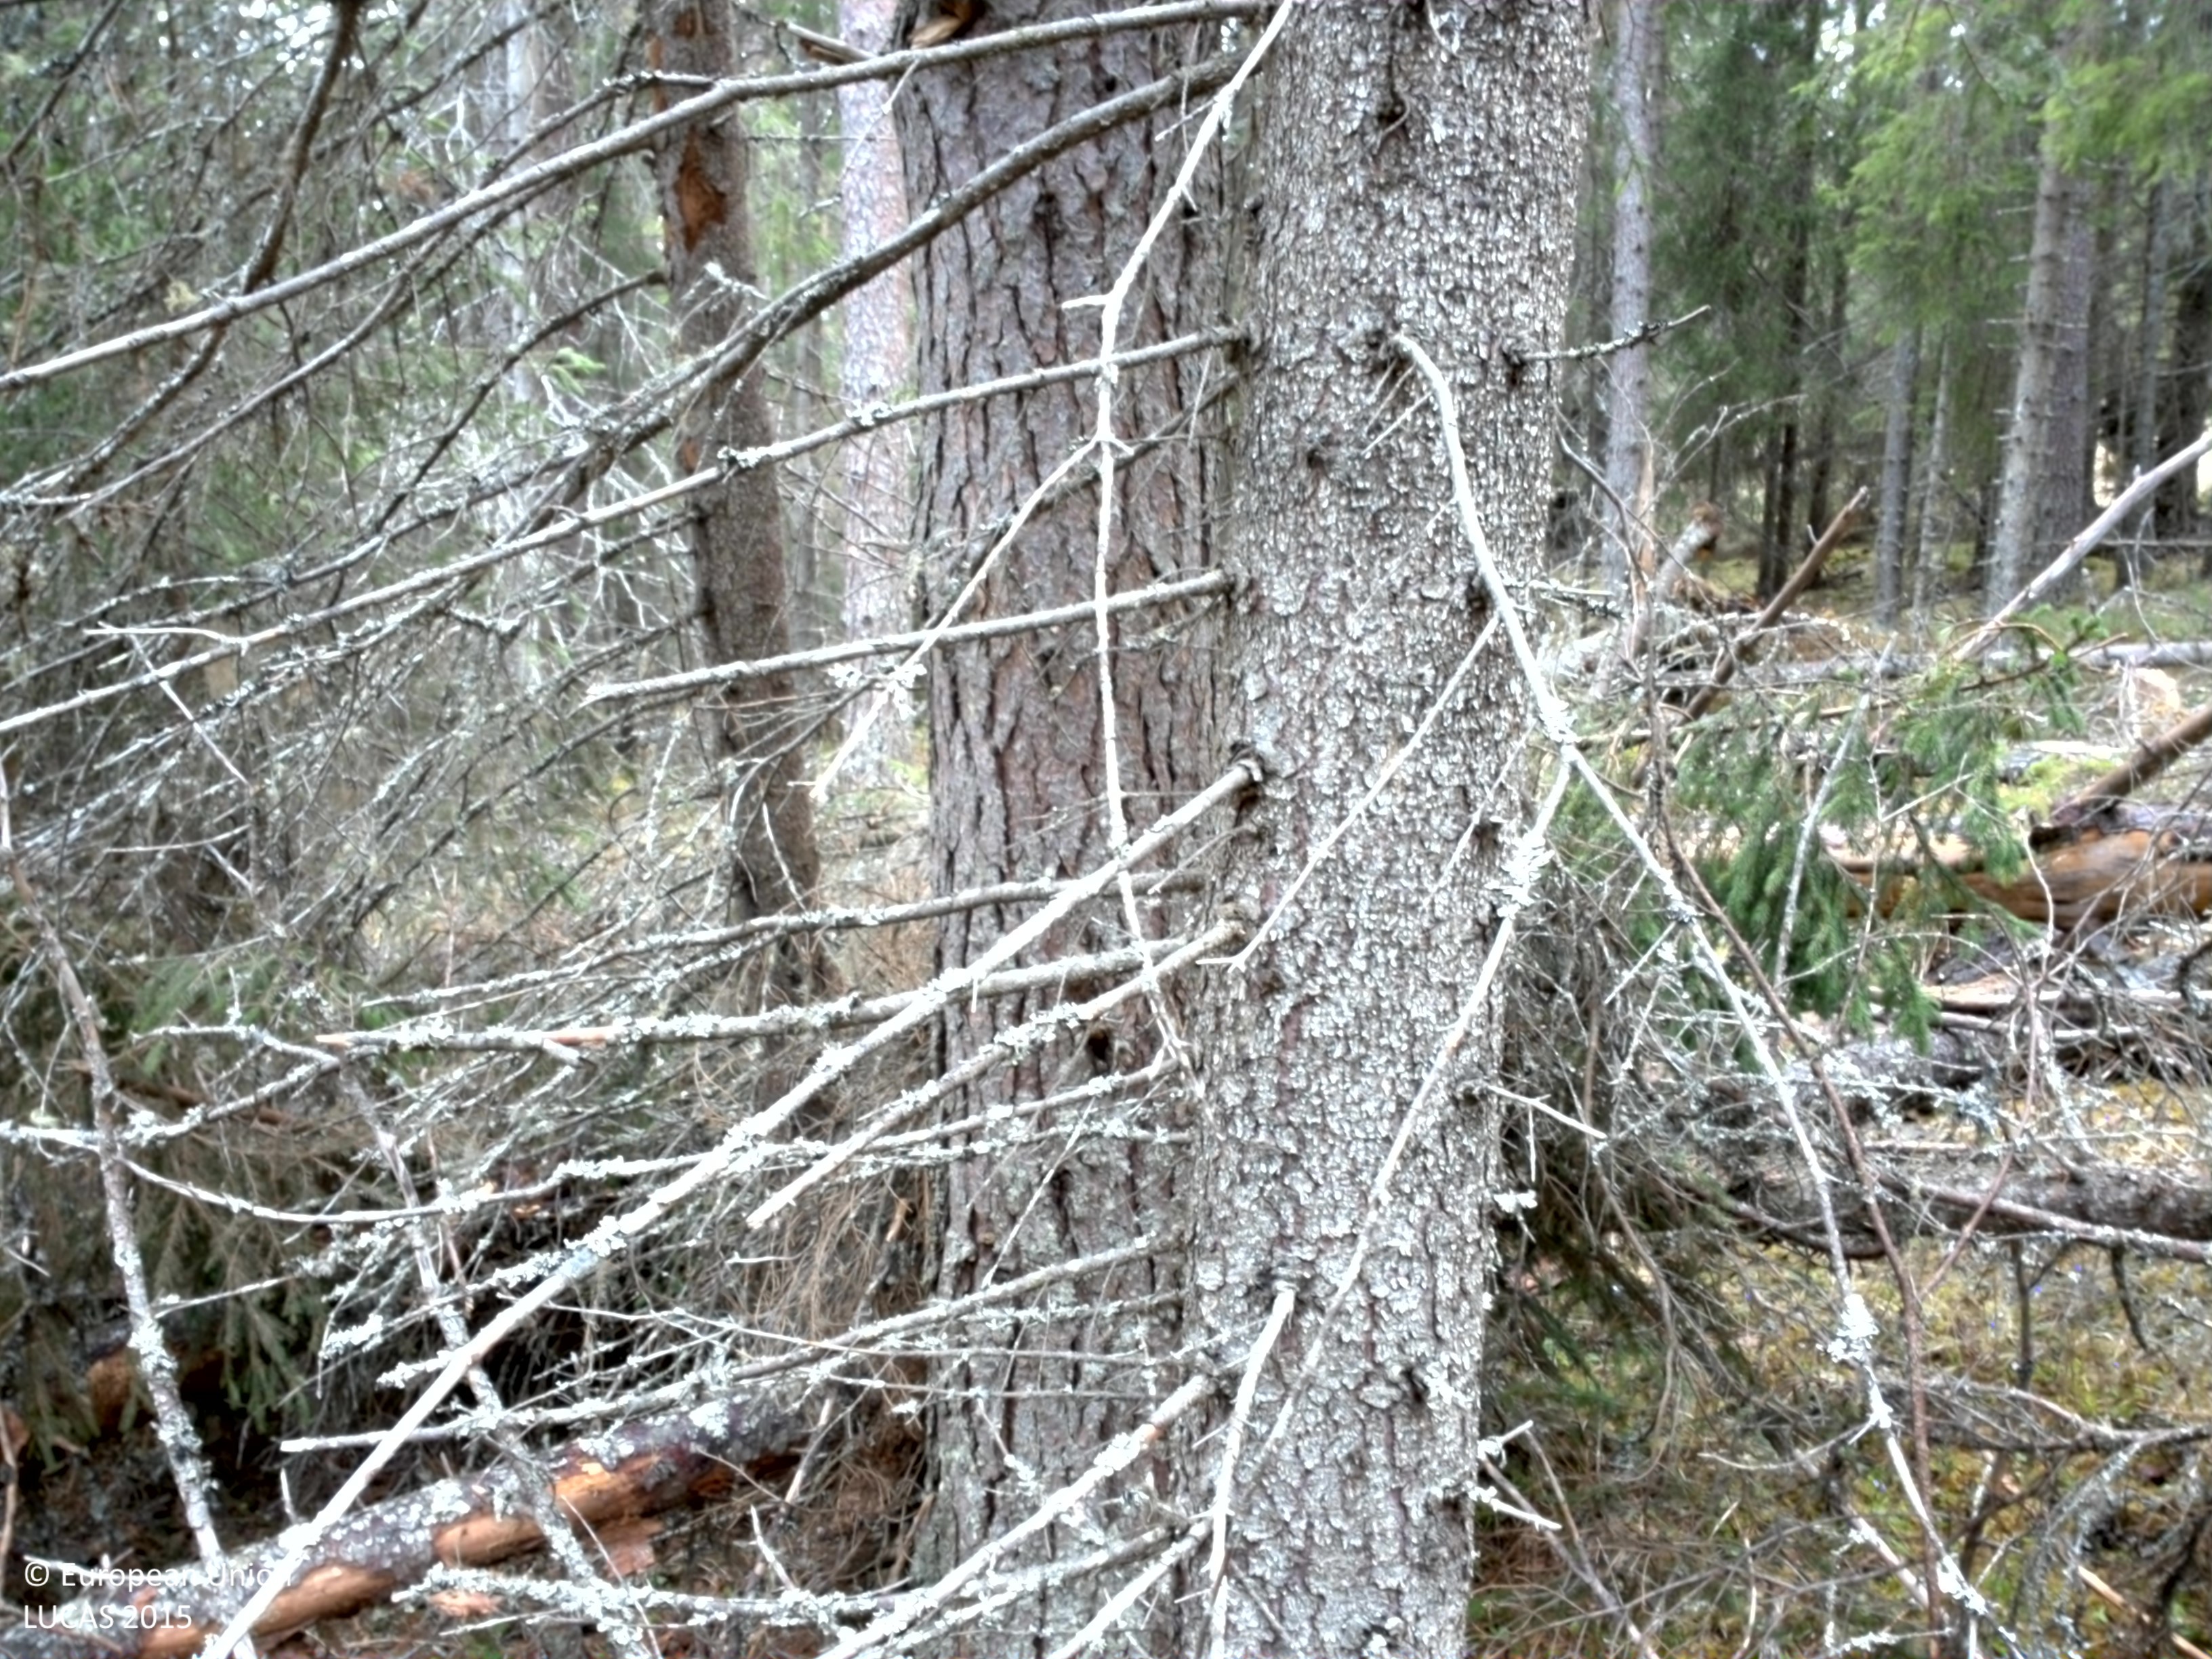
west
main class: Woodland
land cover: Spruce dominated coniferous woodland
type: boreal forest
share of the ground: > 75 %
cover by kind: coniferous forest trees 80 %, lichens and mosses 15 %, broadleaved forest trees 5 %
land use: Forestry
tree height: > 5 m
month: May
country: SE
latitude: 63.3758
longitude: 13.8409
